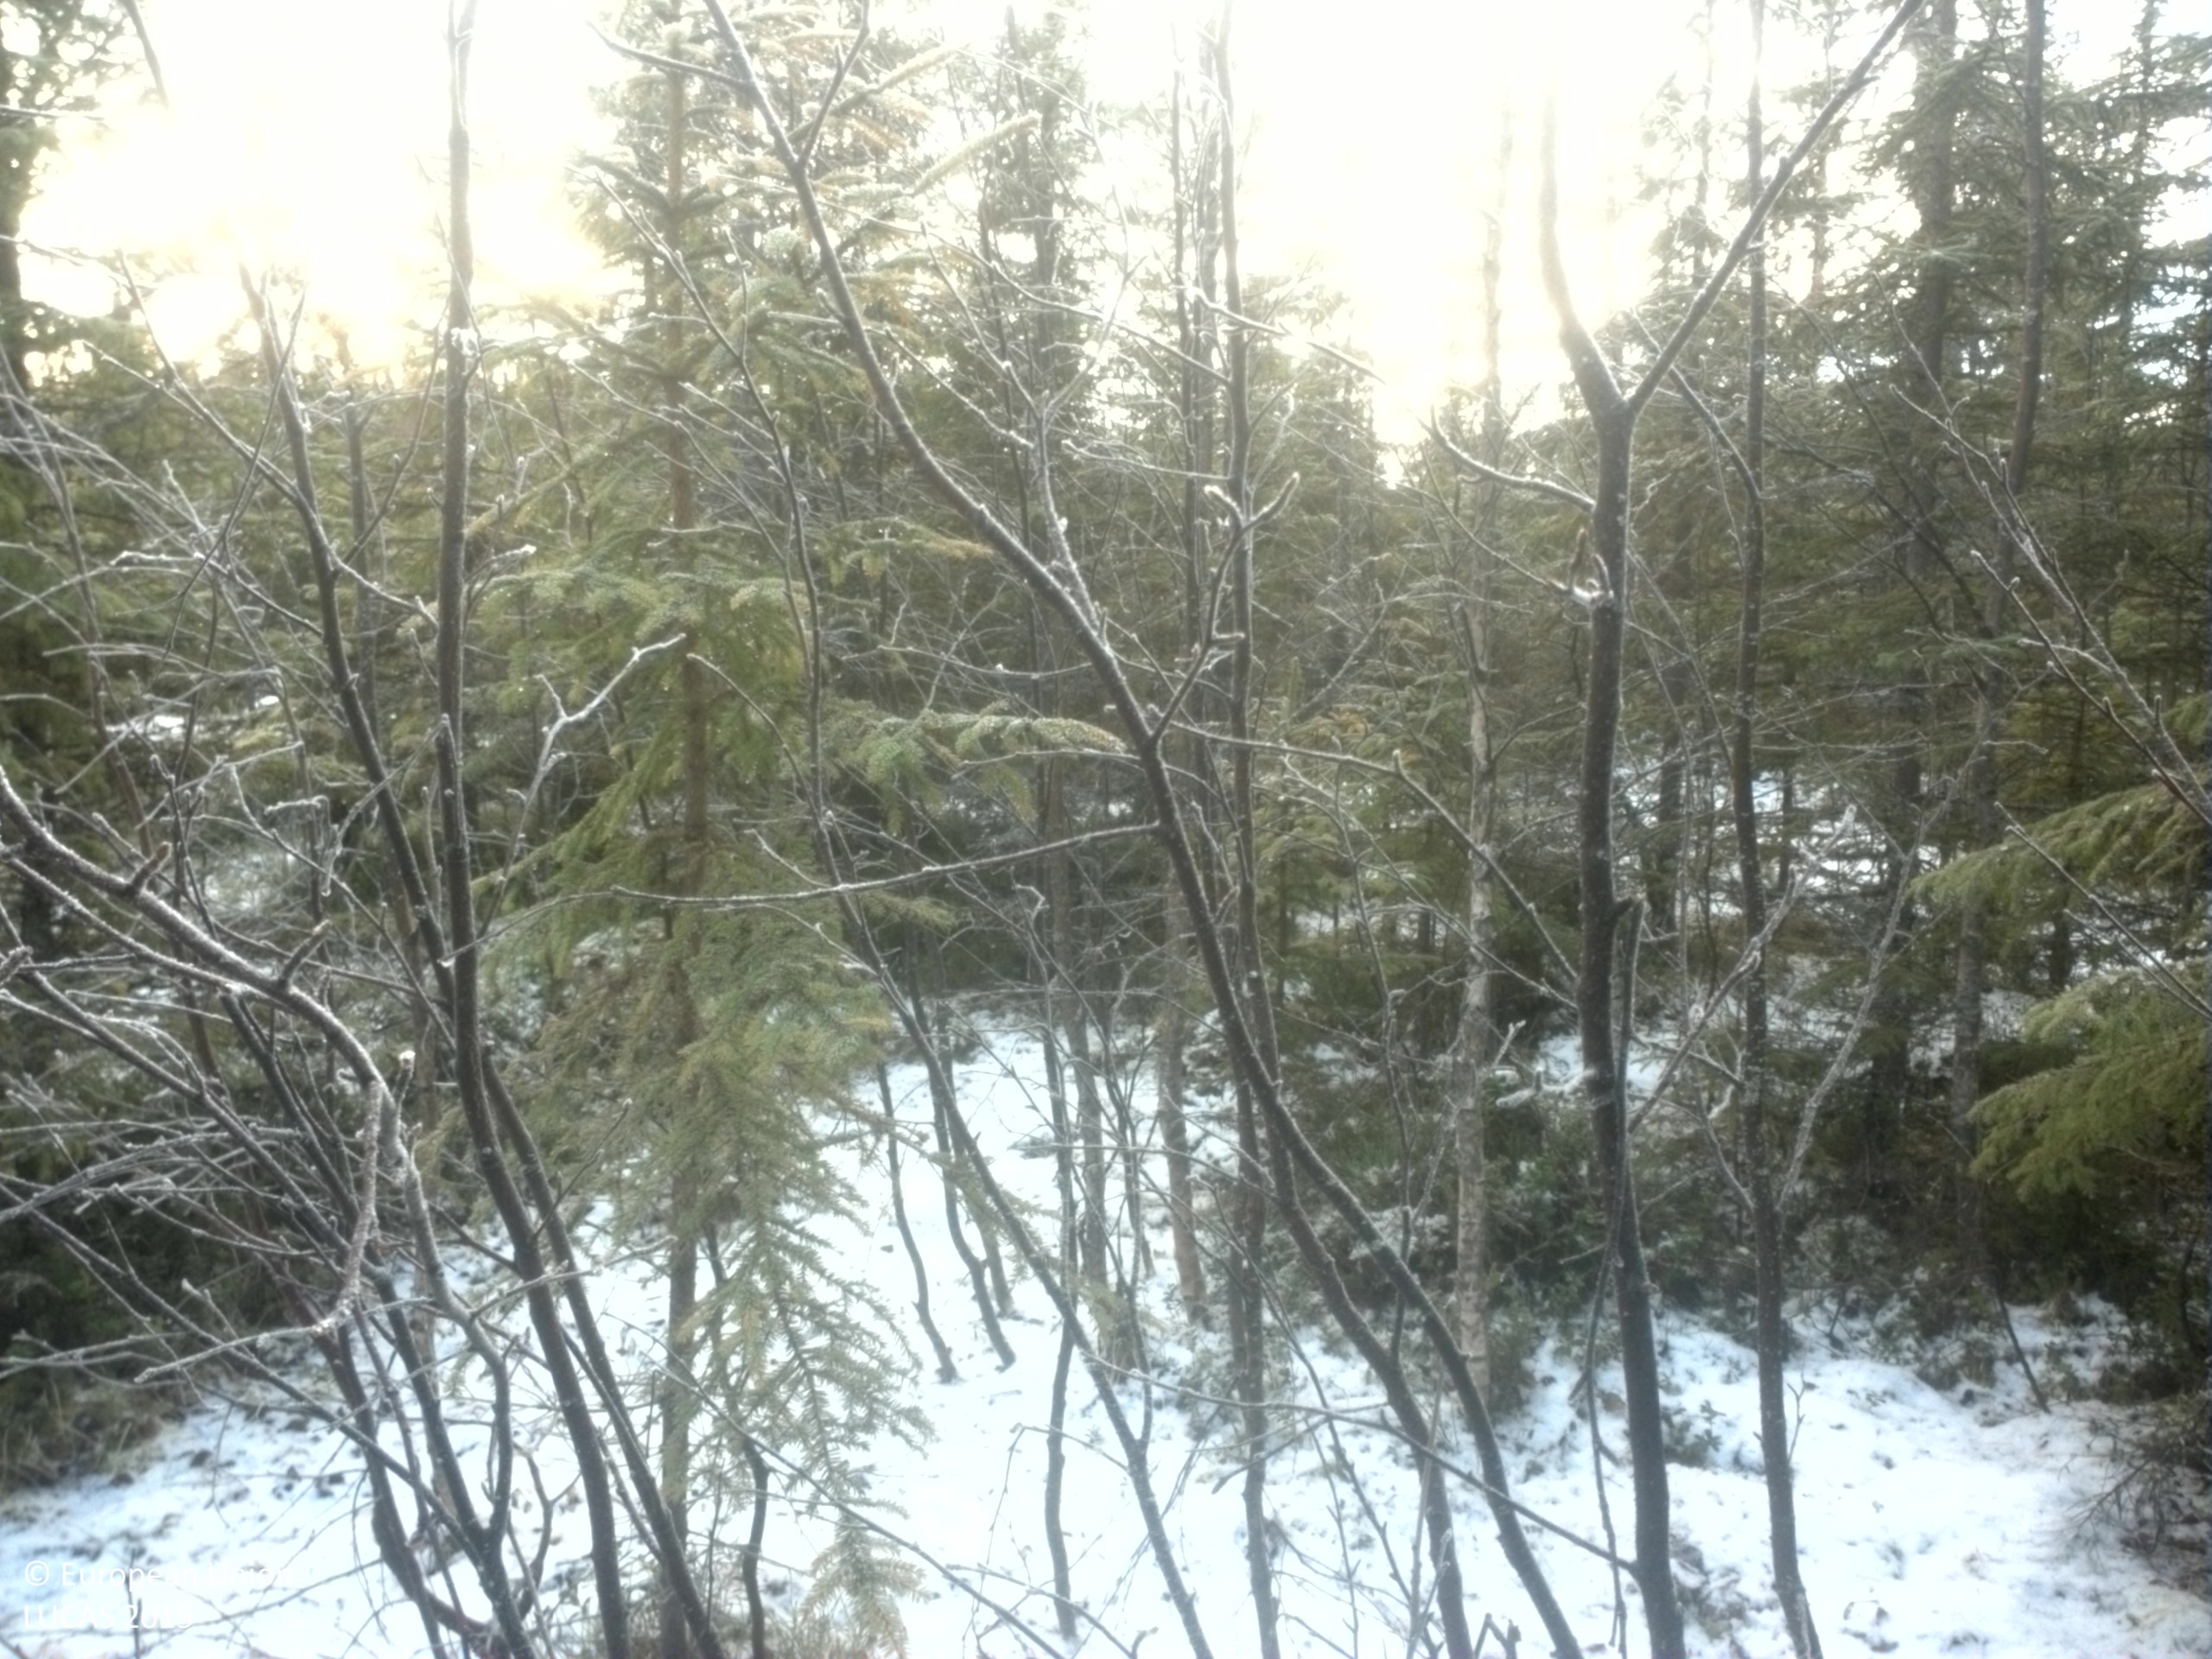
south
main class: Woodland
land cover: Spruce dominated mixed woodland
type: boreal forest
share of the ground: 50 - 75 %
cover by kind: coniferous forest trees 35 %, shrubs 25 %, broadleaved forest trees 15 %, lichens and mosses 15 %, herbaceous plants 10 %
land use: Forestry
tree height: < 5 m
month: November
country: SE
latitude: 63.9050
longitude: 15.9833
